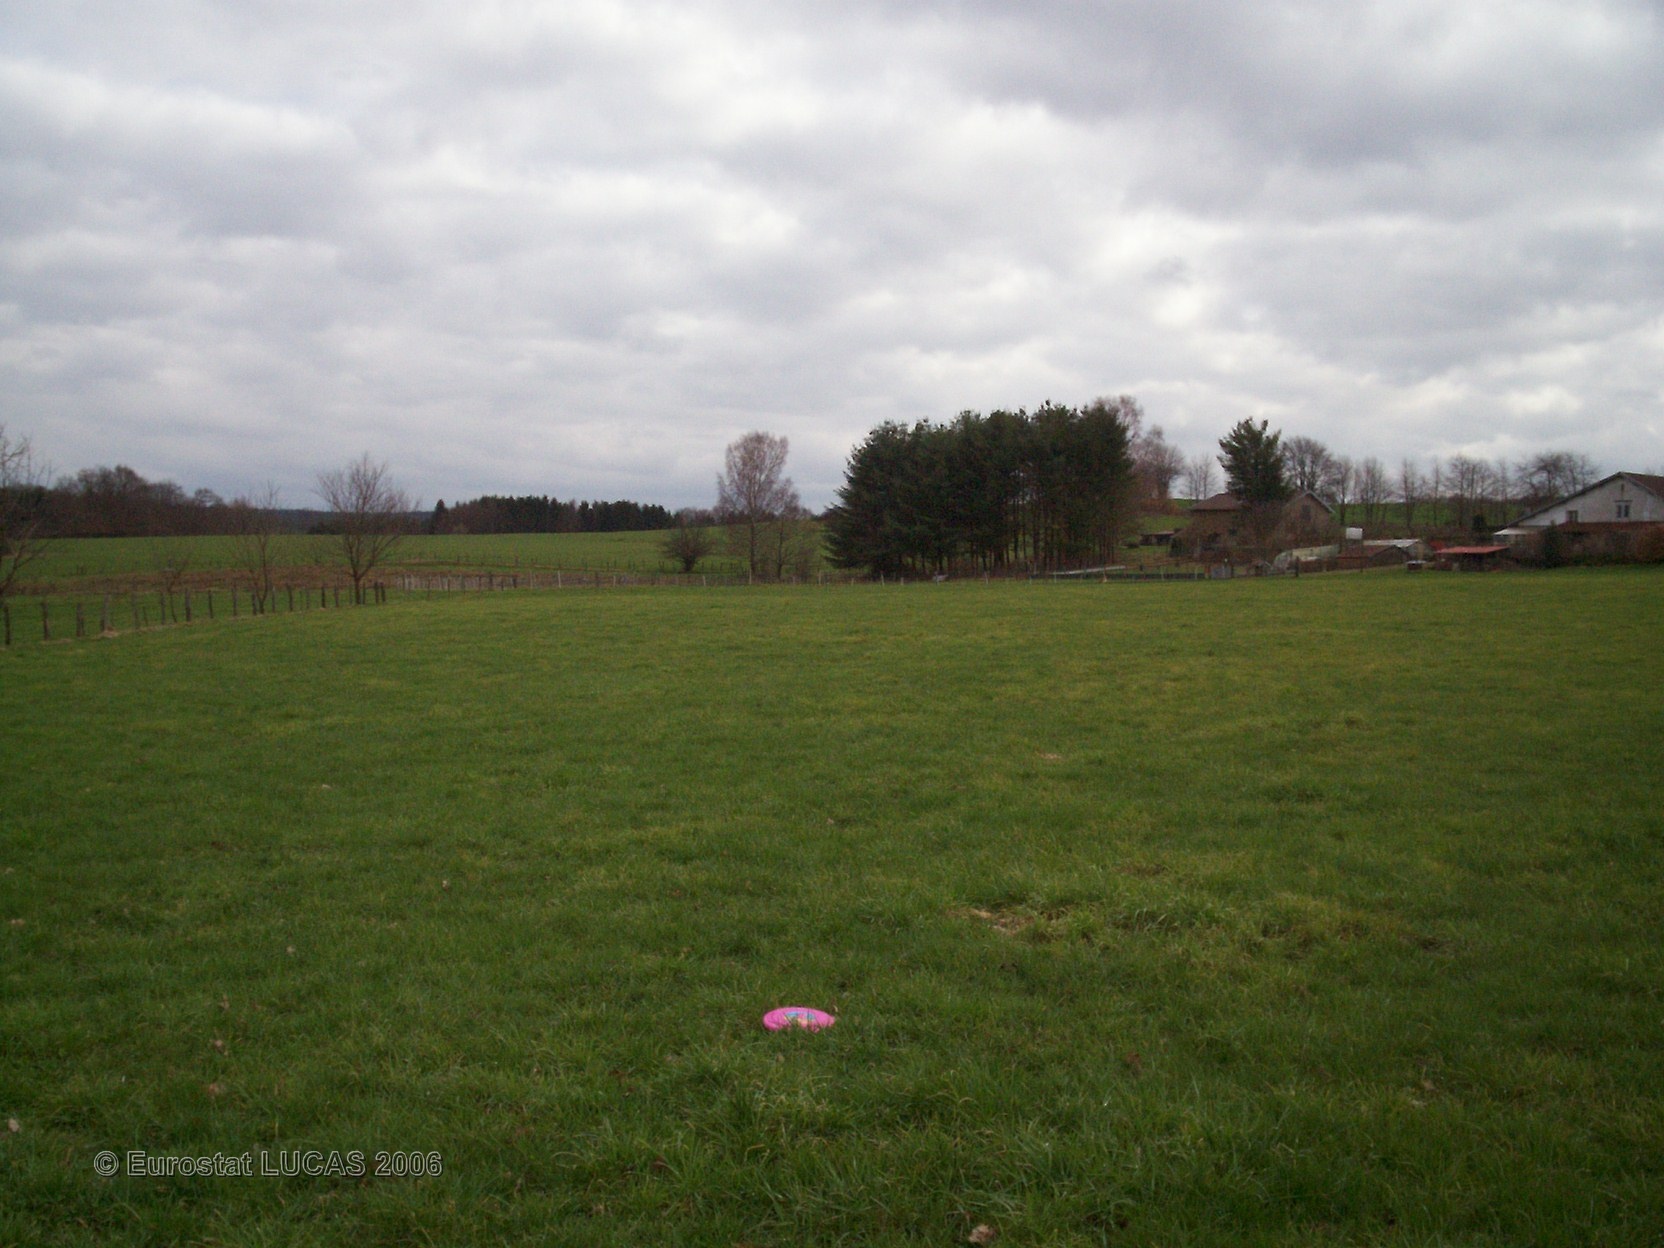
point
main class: Grassland
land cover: Grassland without tree/shrub cover
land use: Agriculture (excluding fallow land and kitchen gardens)
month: April
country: FR
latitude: 48.0240
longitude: 6.5013
